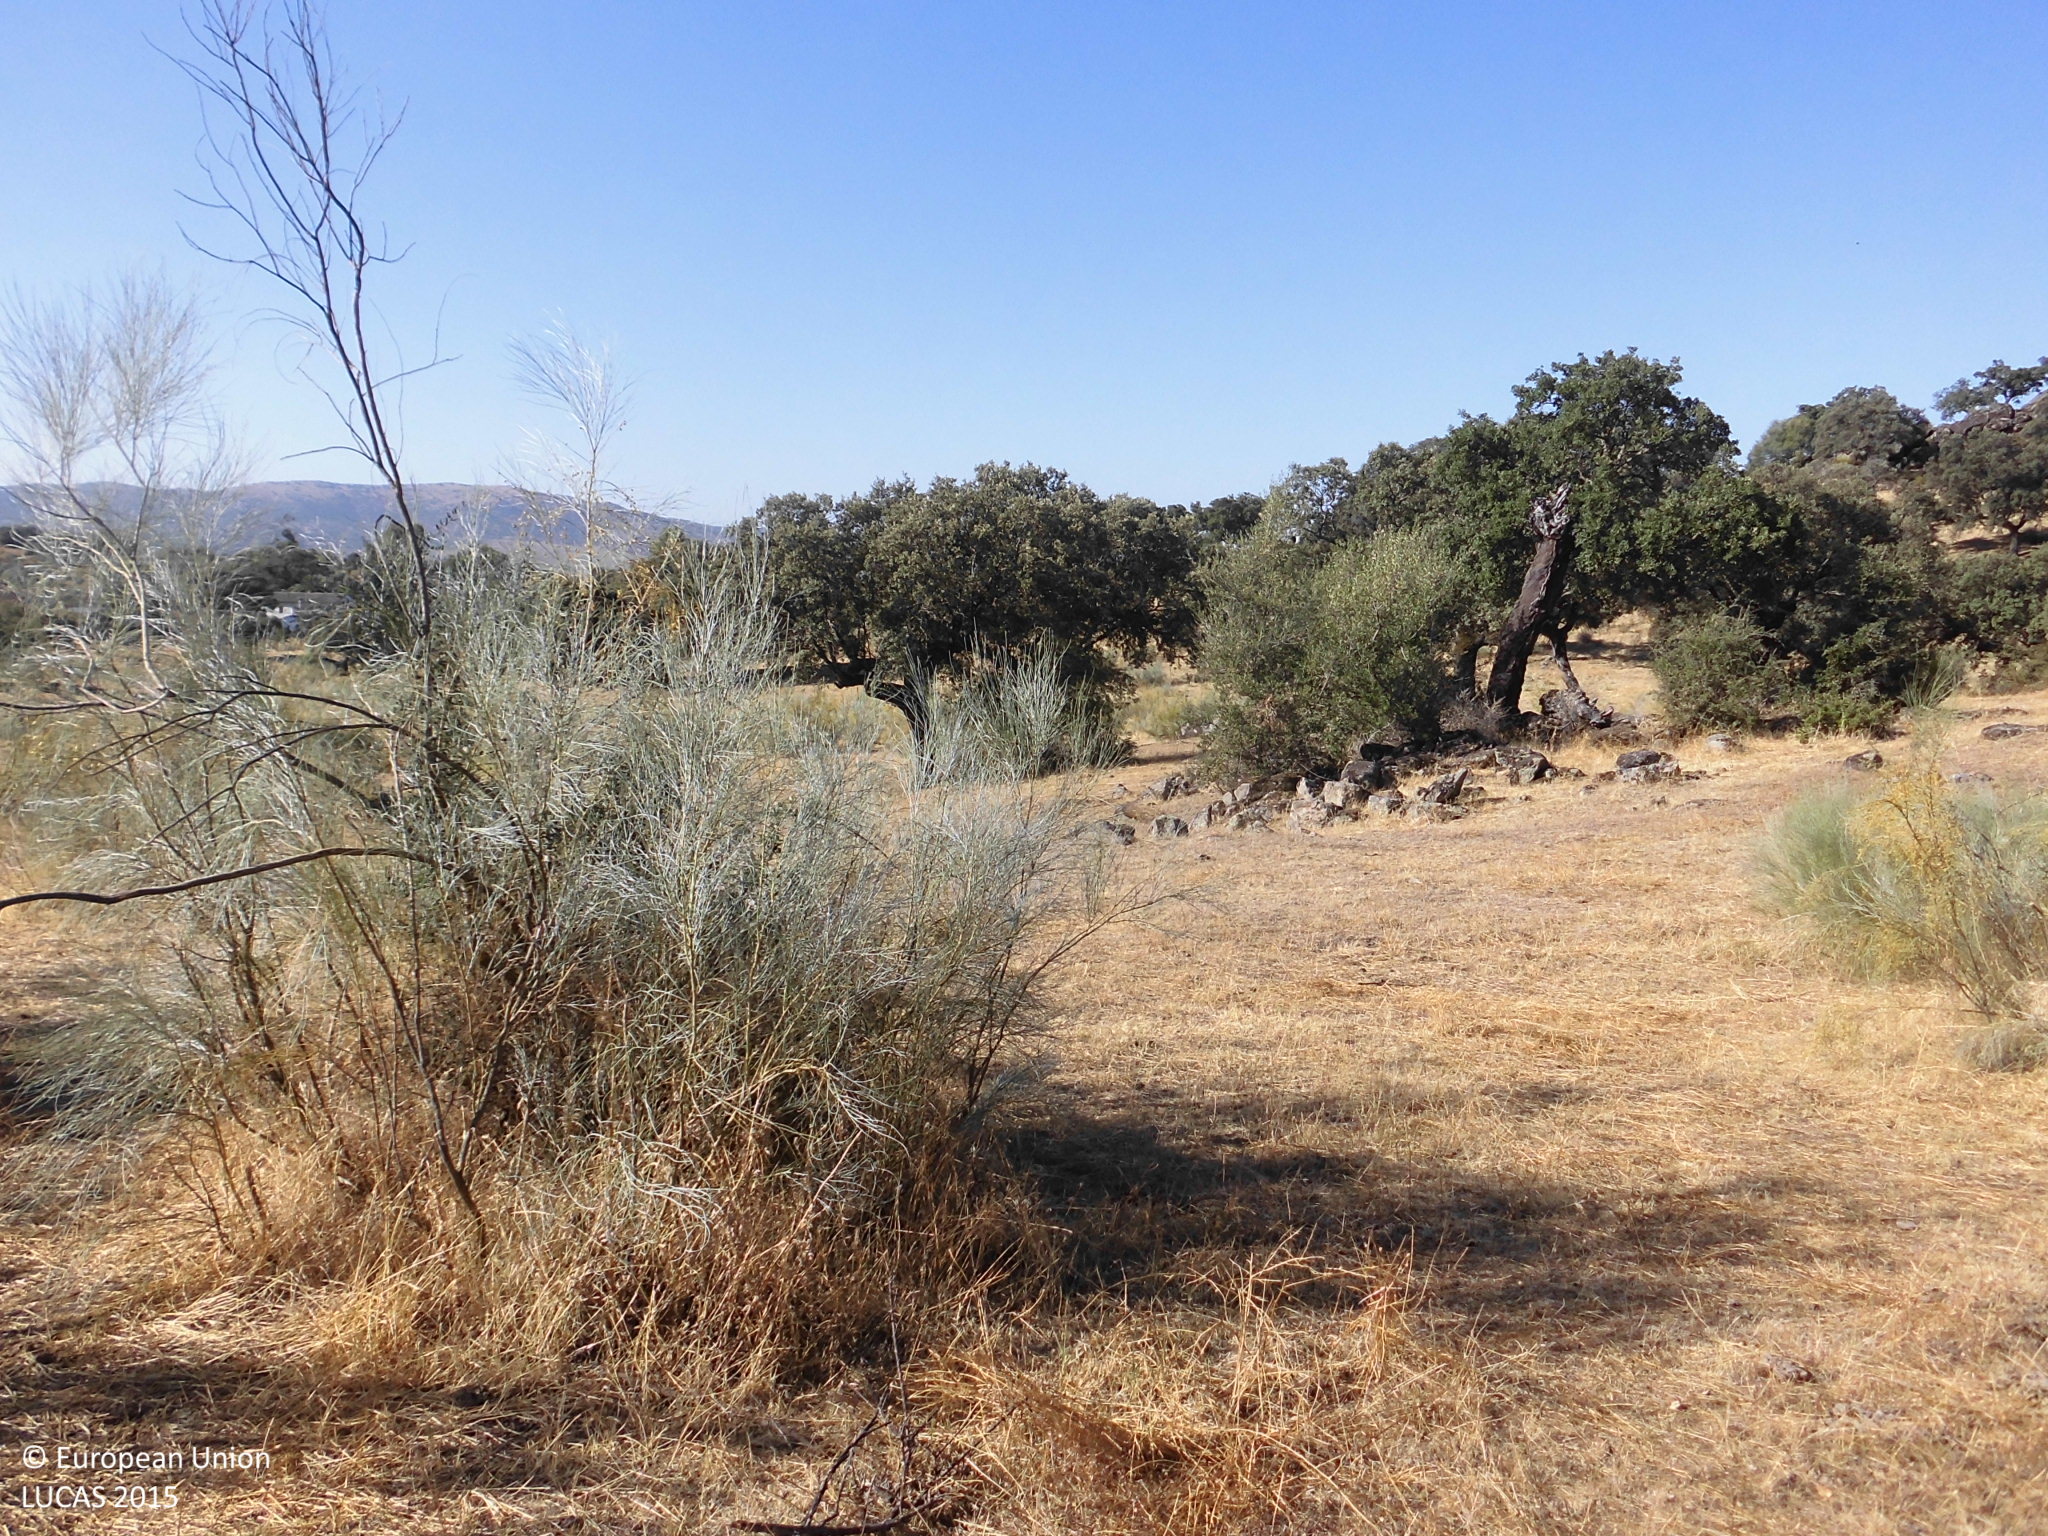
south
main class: Woodland
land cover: Broadleaved woodland
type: broadleaved evergreen forest
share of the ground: 10 - 25 %
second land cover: Shrubland without tree cover
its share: 50 - 75 %
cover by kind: shrubs 50 %, herbaceous plants 40 %, broadleaved forest trees 10 %
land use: Forestry
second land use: Agriculture (excluding fallow land and kitchen gardens)
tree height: > 5 m
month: July
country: ES
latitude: 40.0750
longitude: -6.1738
